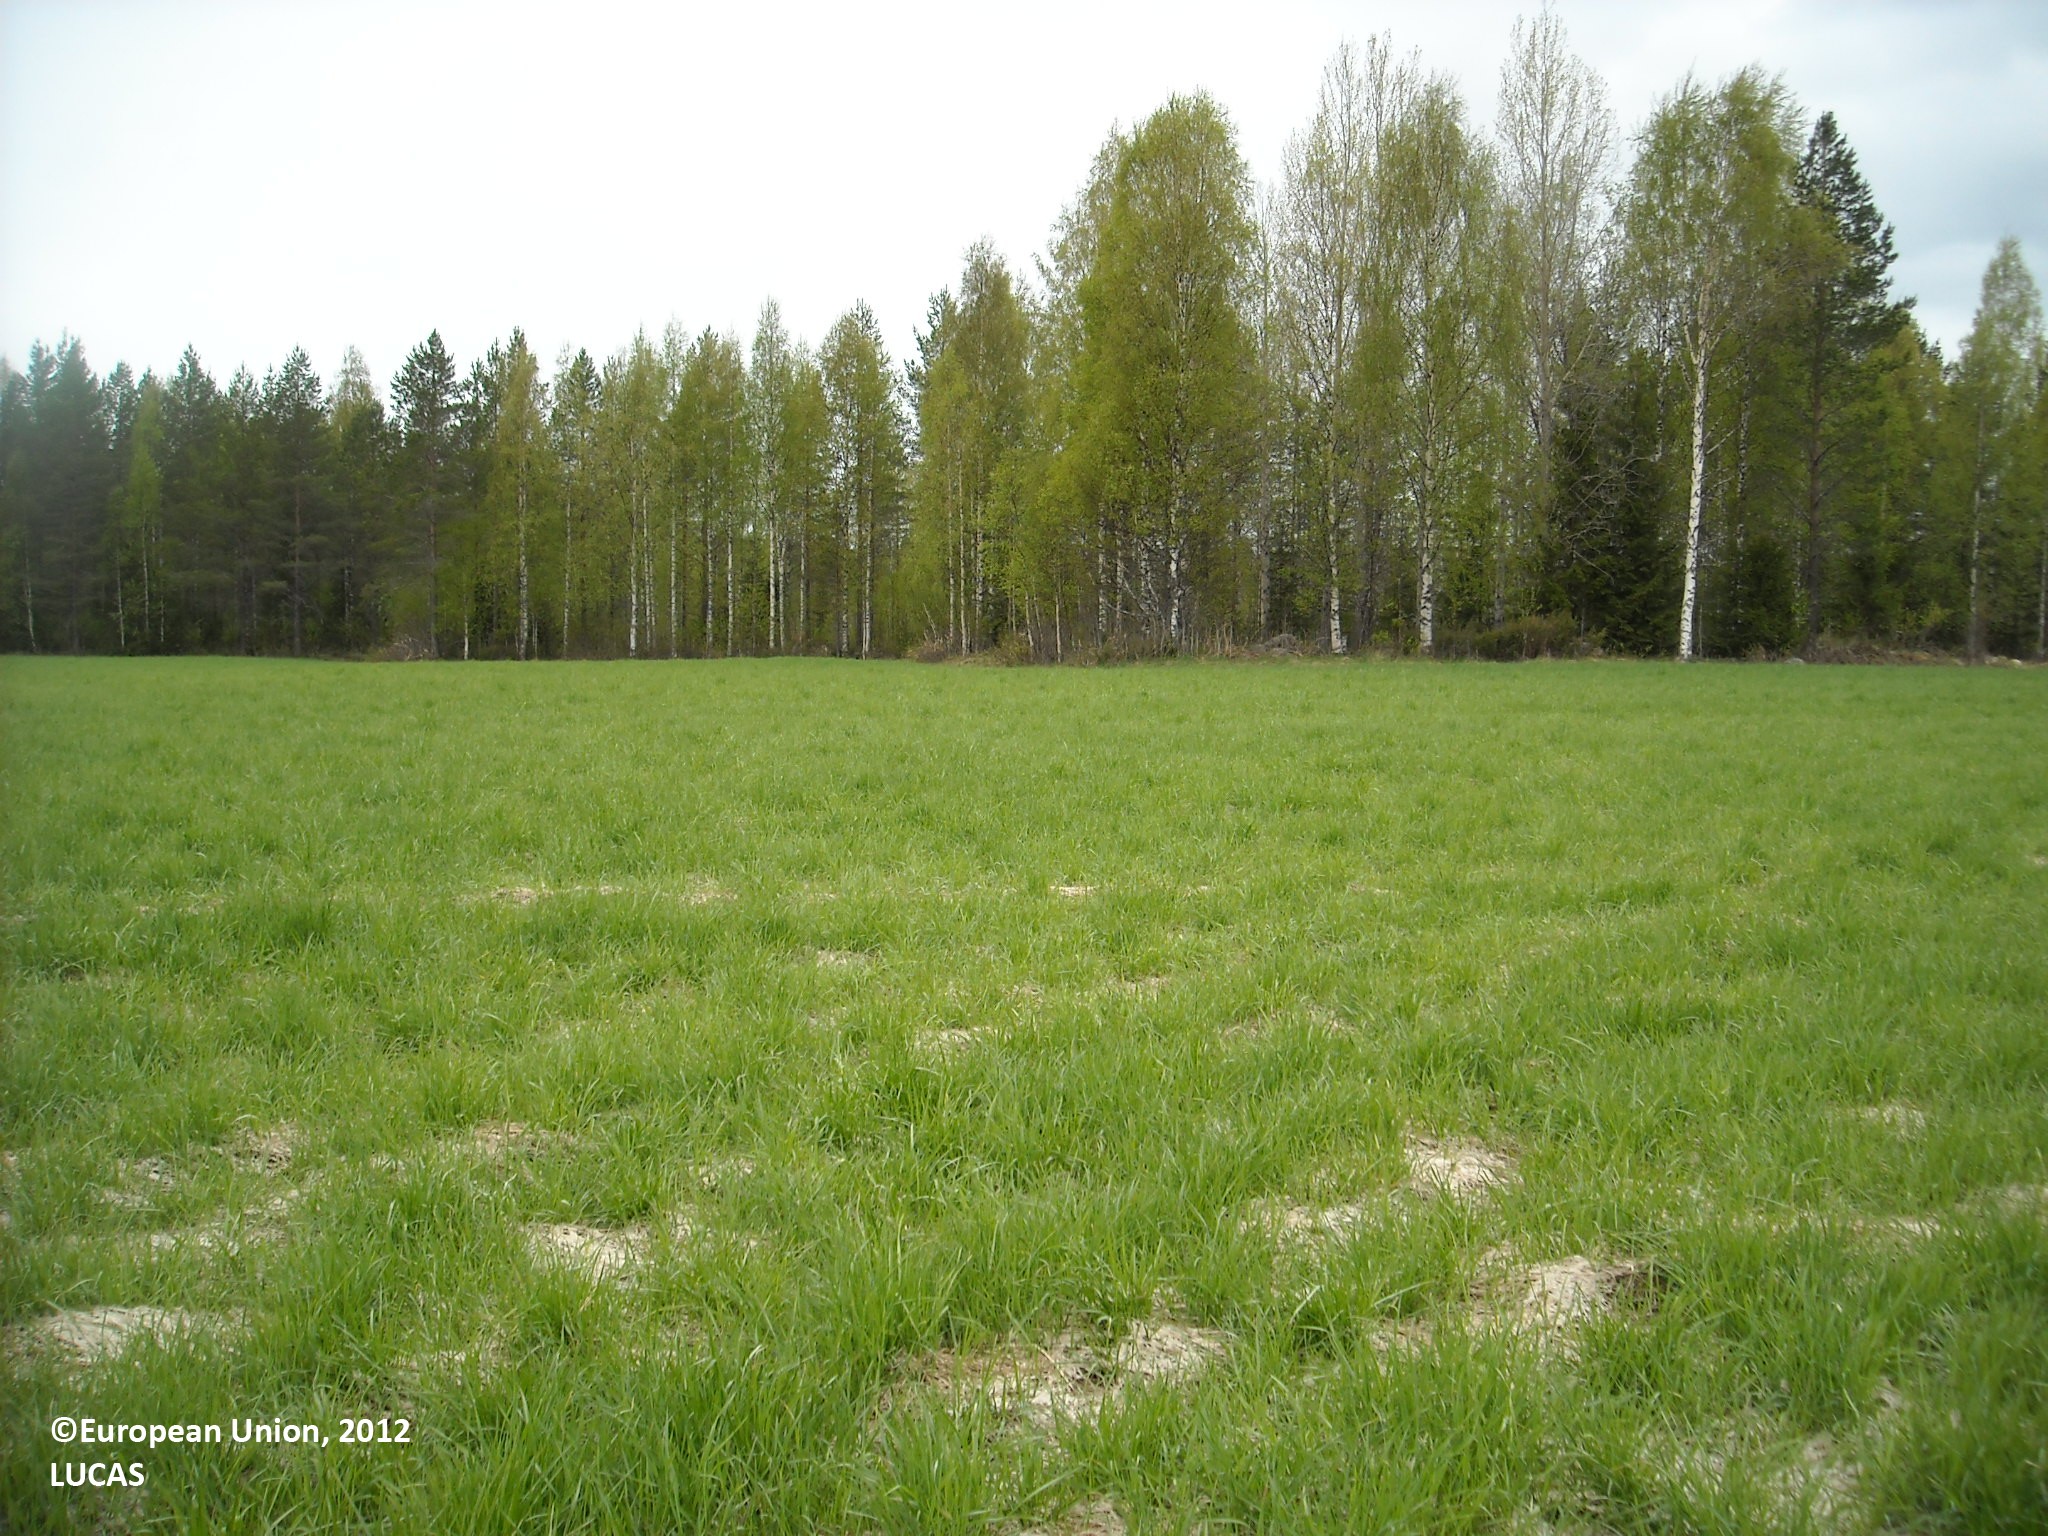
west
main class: Cropland
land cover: Temporary grasslands
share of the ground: > 75 %
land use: Agriculture (excluding fallow land and kitchen gardens)
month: June
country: FI
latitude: 64.6910
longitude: 27.3914
